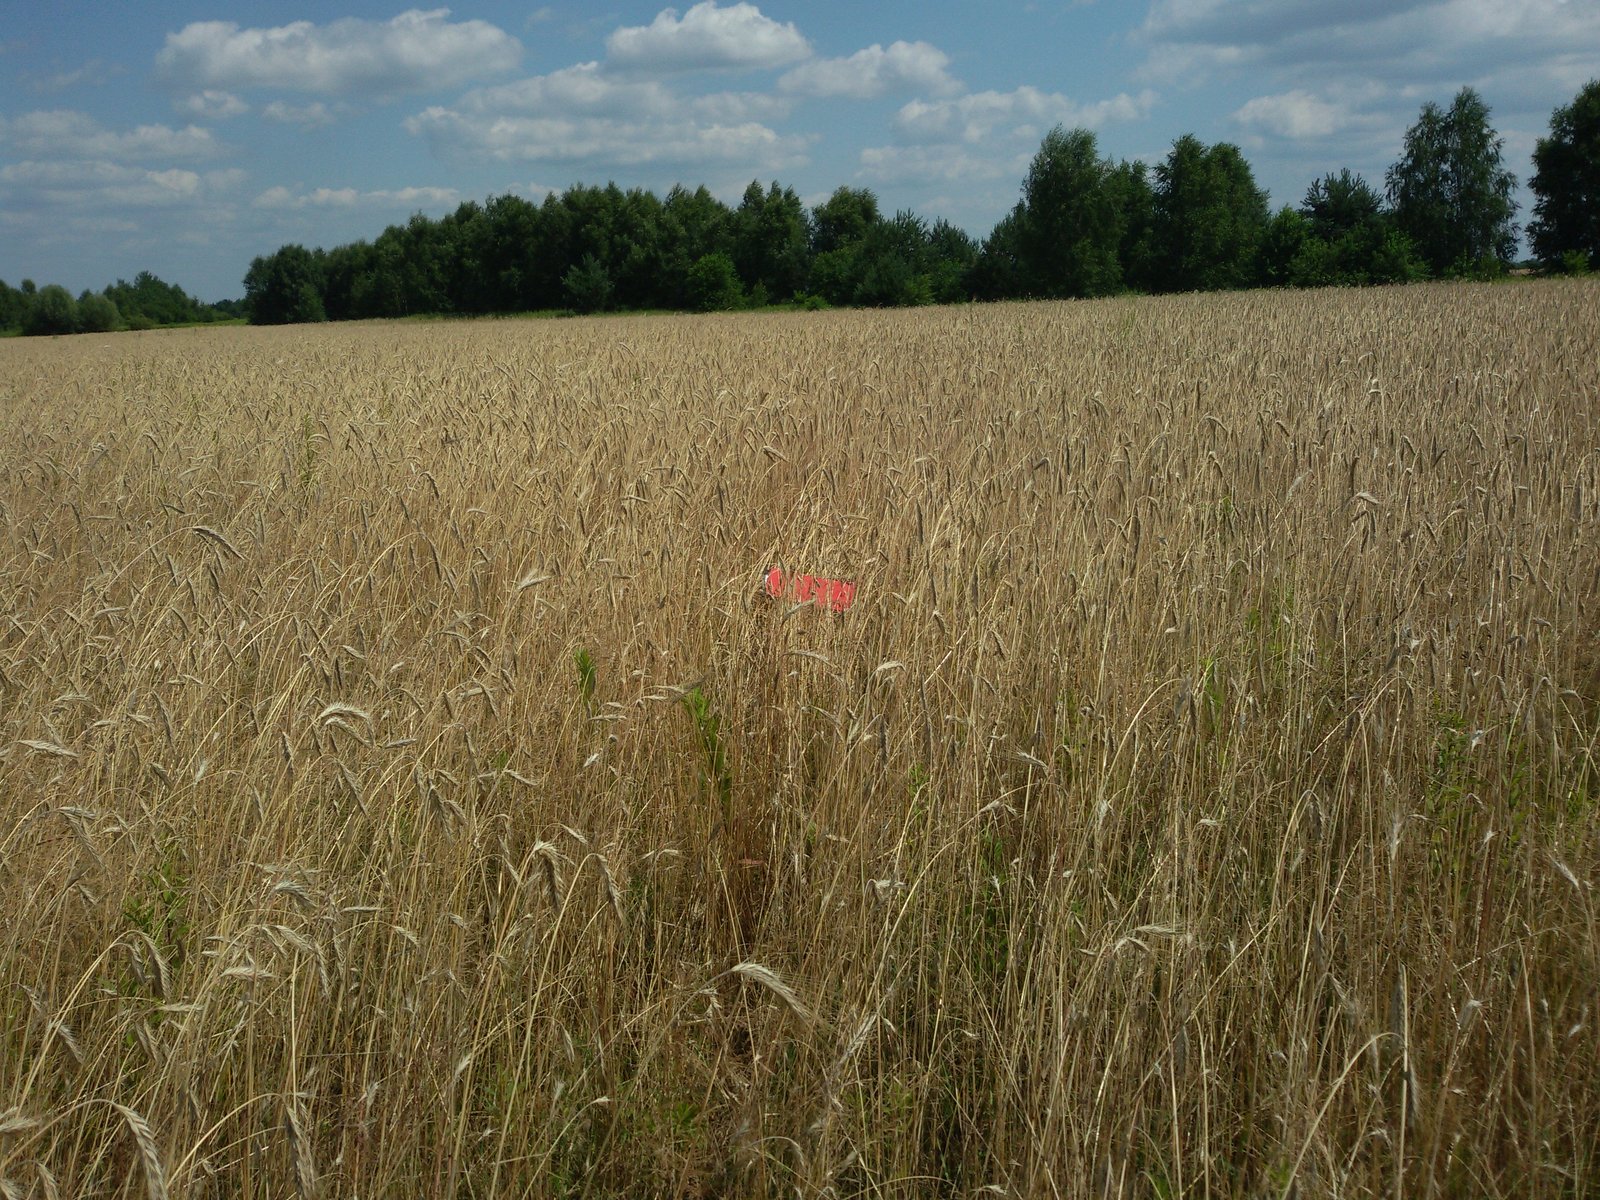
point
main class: Cropland
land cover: Rye
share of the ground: > 75 %
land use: Agriculture (excluding fallow land and kitchen gardens)
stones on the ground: < 10 %
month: July
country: PL
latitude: 50.2512
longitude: 22.3914
